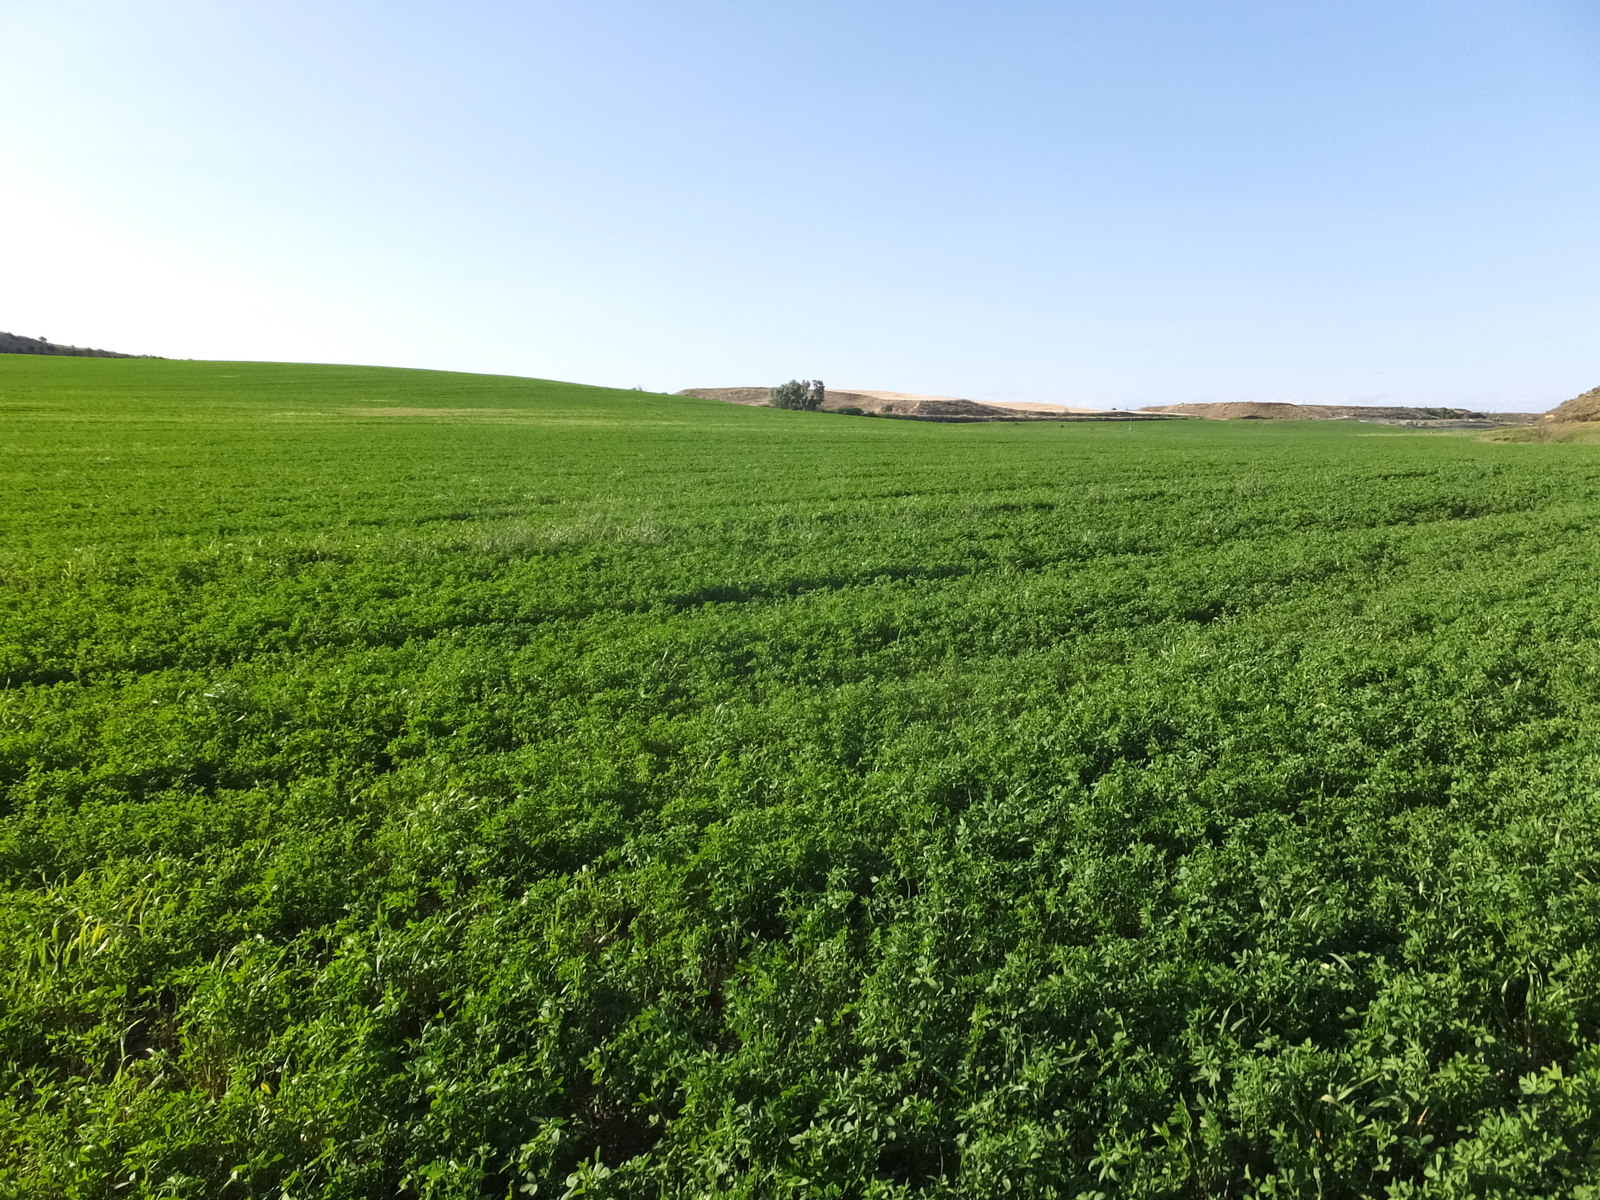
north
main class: Cropland
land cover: Lucerne
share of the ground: > 75 %
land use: Agriculture (excluding fallow land and kitchen gardens)
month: May
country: ES
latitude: 41.6353
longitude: 0.4190
